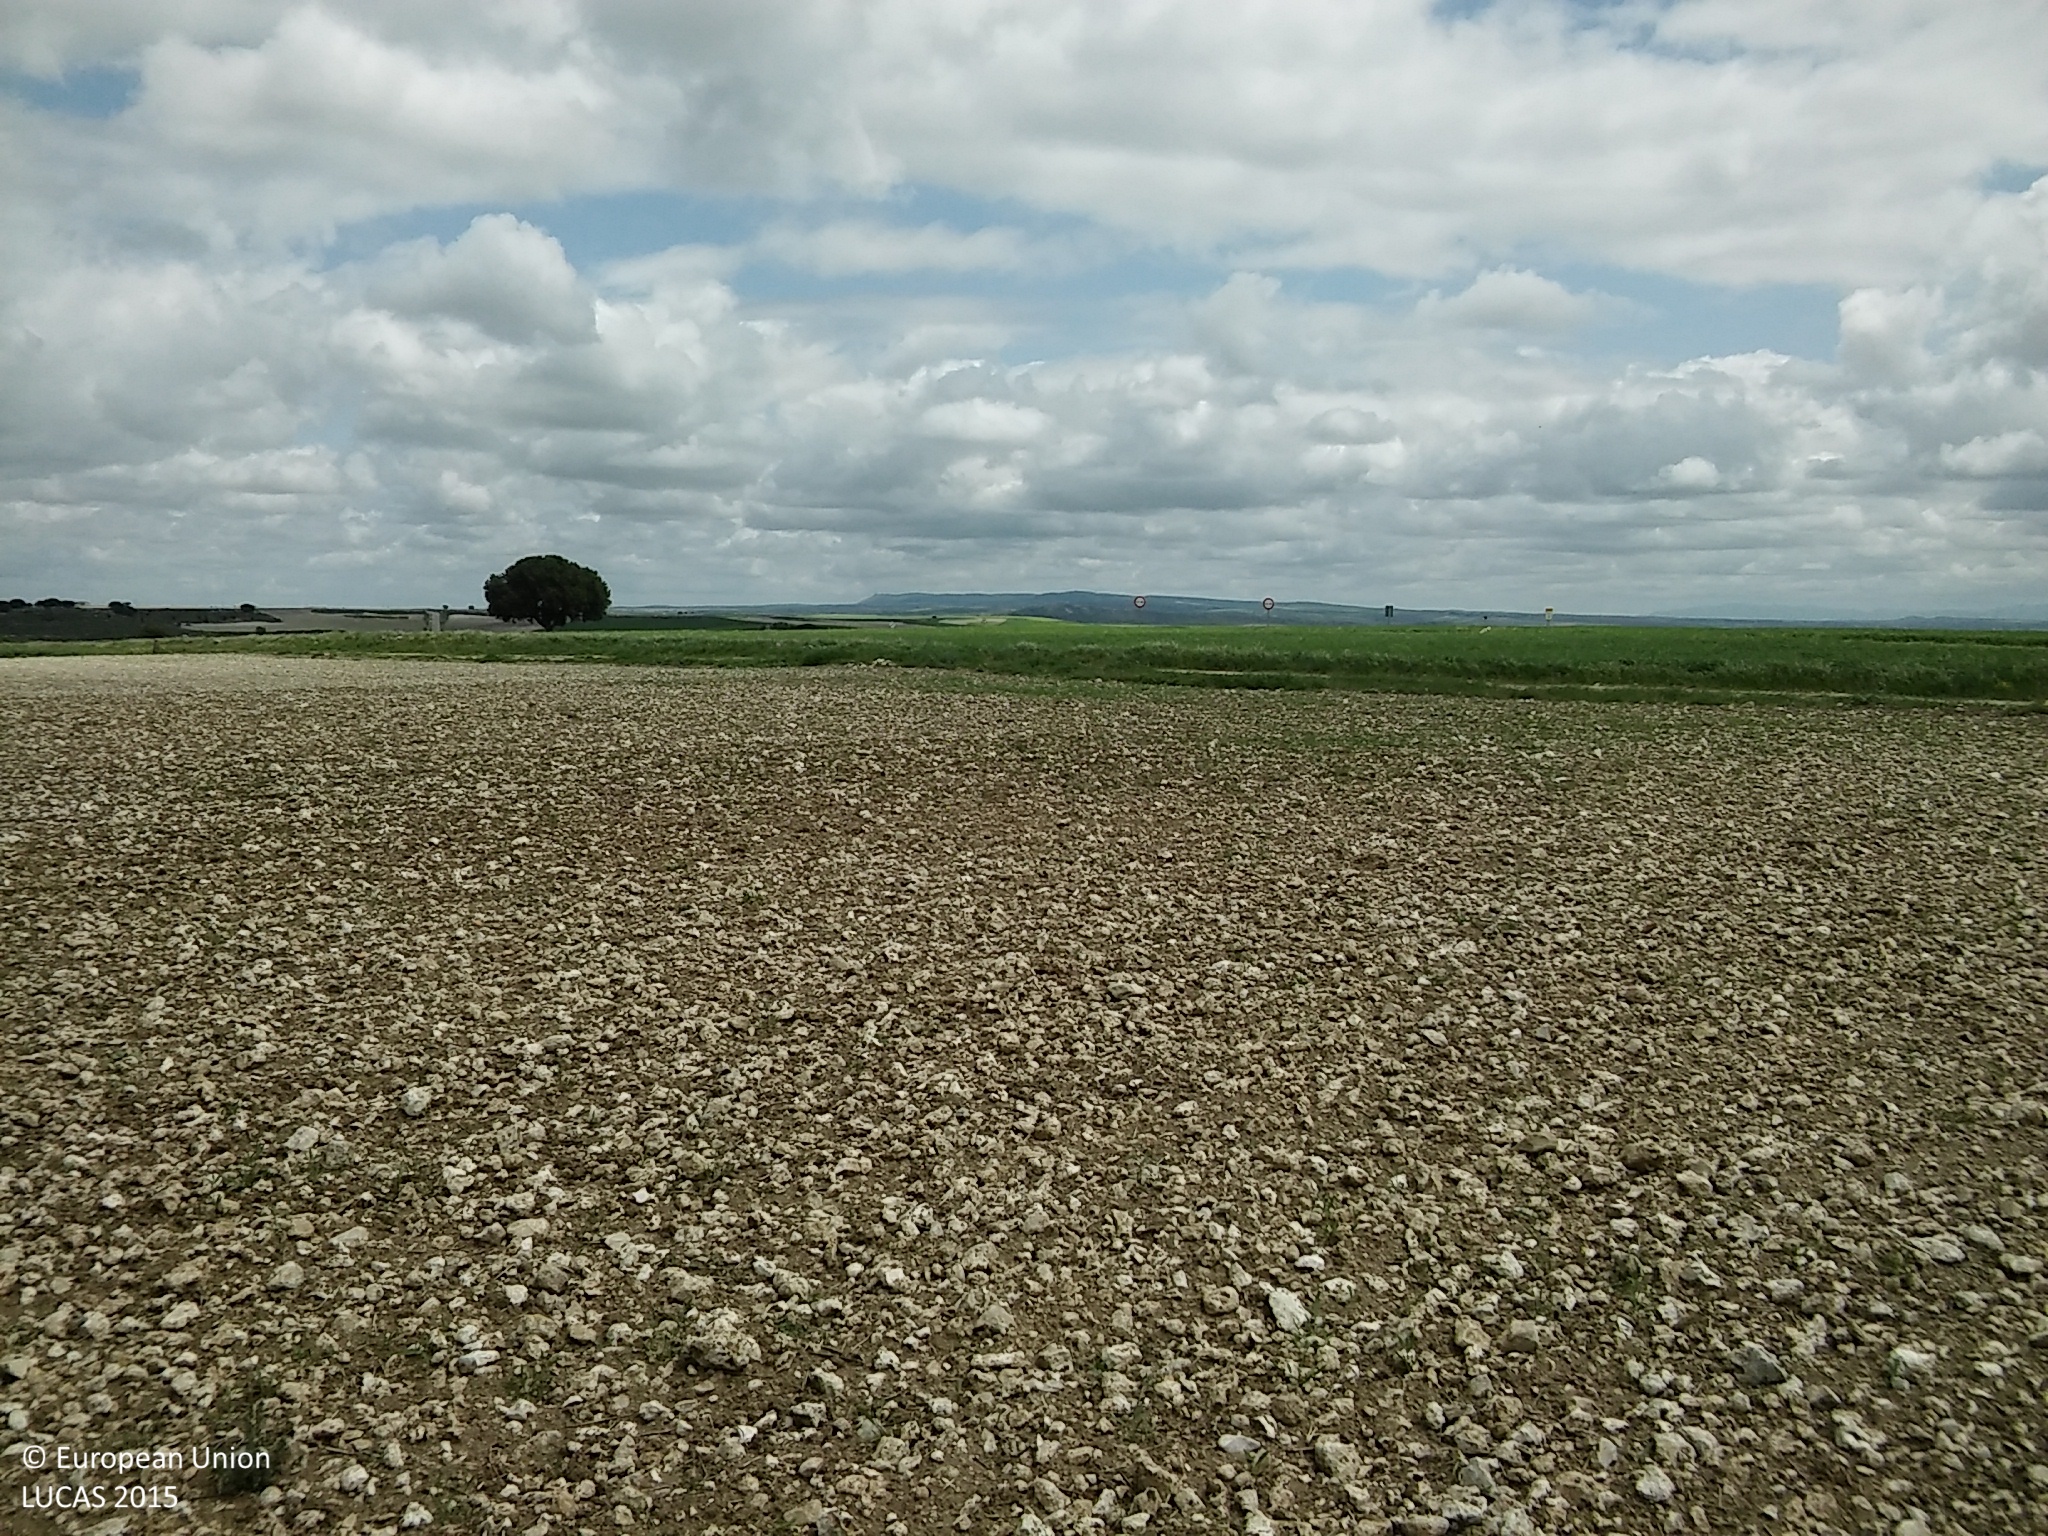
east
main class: Cropland
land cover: Sunflower
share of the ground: < 10 %
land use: Agriculture (excluding fallow land and kitchen gardens)
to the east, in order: Sunflower; Grass margins; Tracks; Grass margins; Barley; Grass margins; Paved roads, cycling and walking lanes; Grass margins; Ditches and canals; Grass margins; Barley
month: May
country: ES
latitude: 41.4320
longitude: -4.0446
